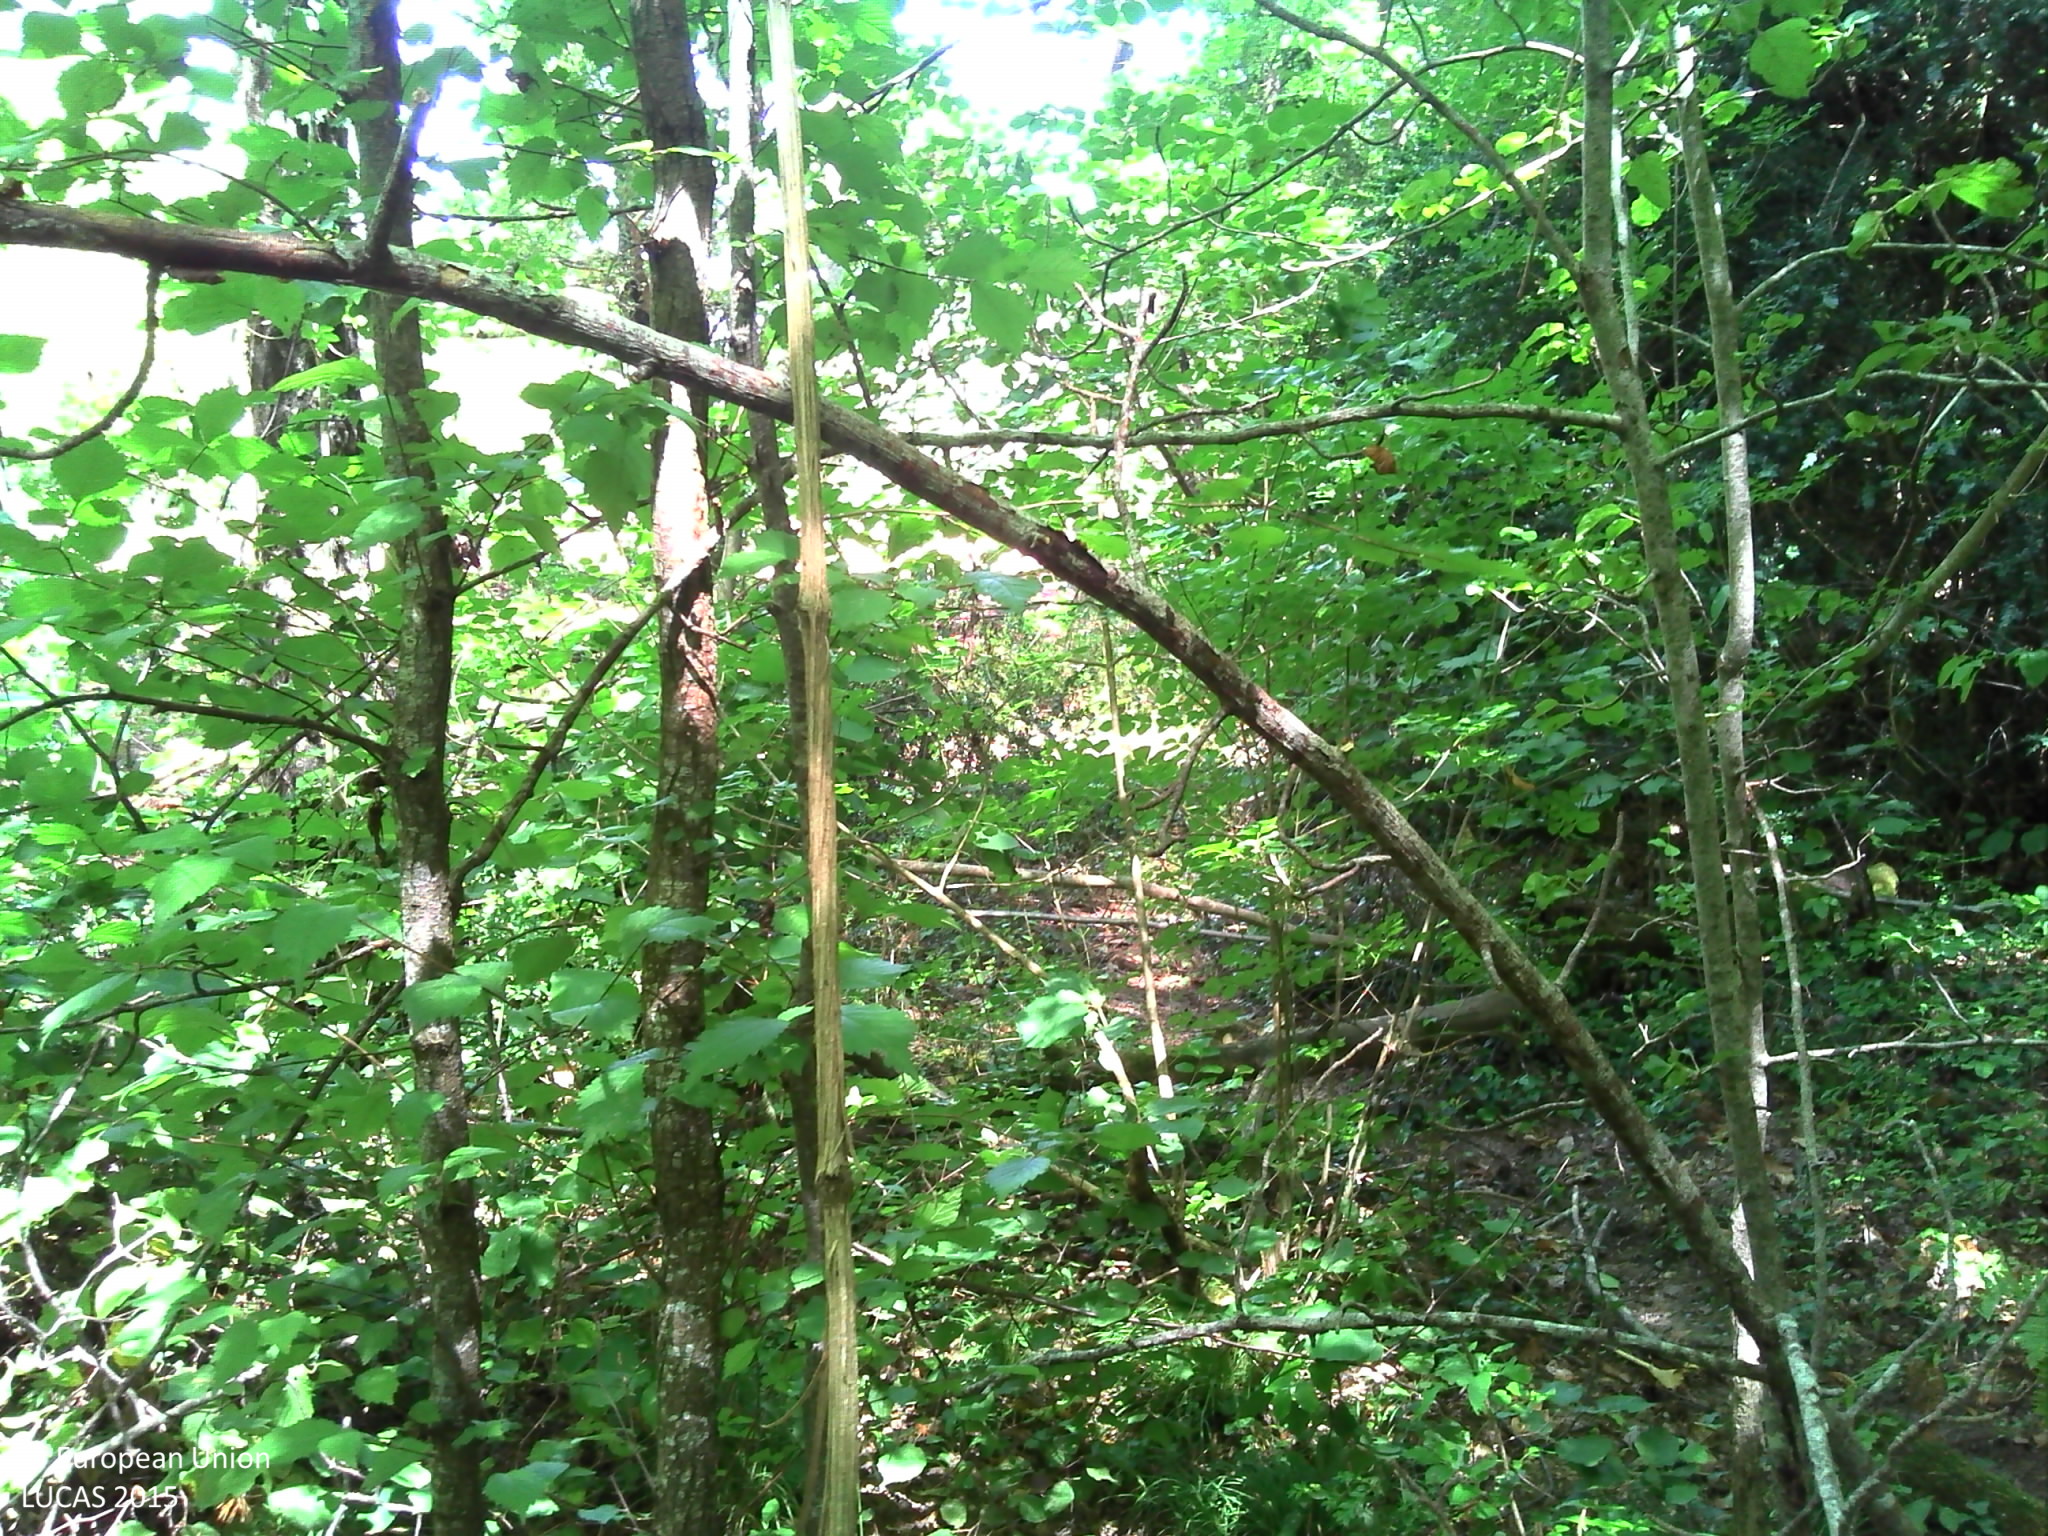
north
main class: Woodland
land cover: Broadleaved woodland
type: mesophytic deciduous forest
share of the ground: > 75 %
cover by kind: broadleaved forest trees 80 %, shrubs 10 %, coniferous forest trees 5 %, lichens and mosses 5 %
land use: Semi-natural and natural areas not in use
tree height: > 5 m
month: August
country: FR
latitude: 43.8804
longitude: 3.0245
